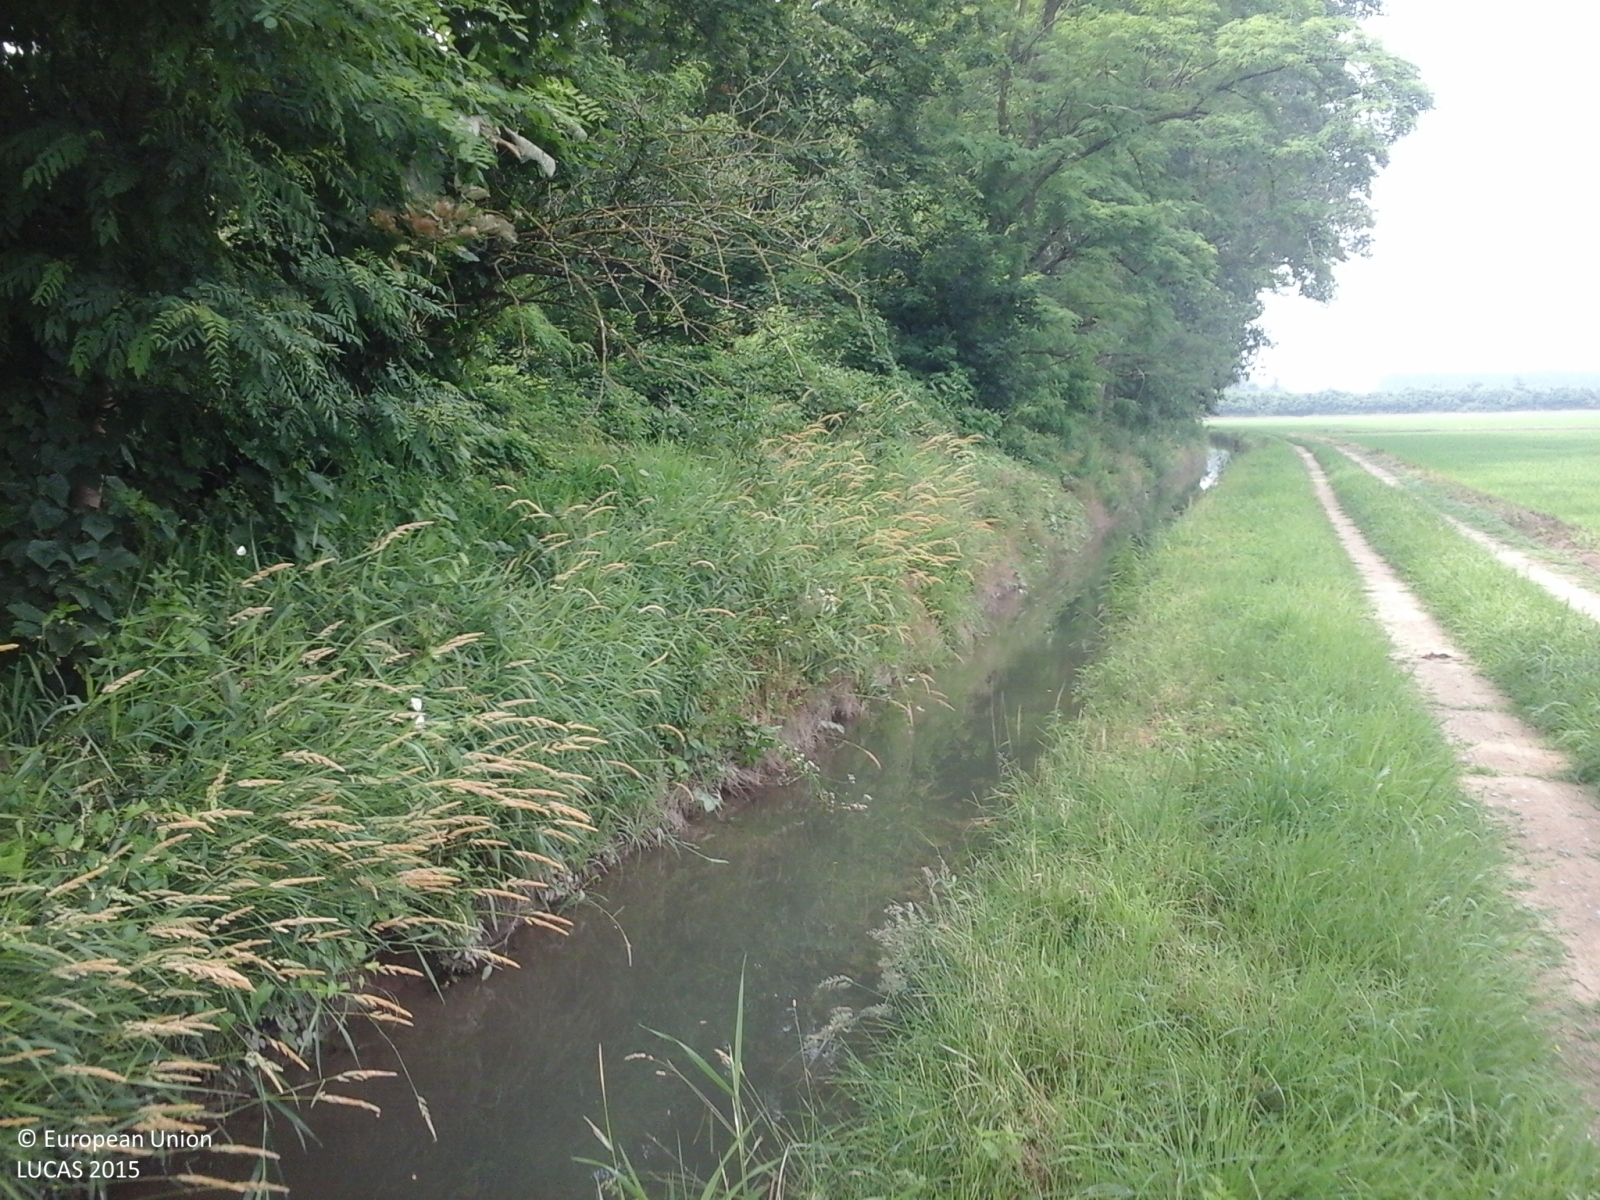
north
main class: Woodland
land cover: Broadleaved woodland
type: thermophilous deciduous forest
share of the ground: > 75 %
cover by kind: broadleaved forest trees 100 %
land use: Forestry
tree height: > 5 m
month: June
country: IT
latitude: 45.1911
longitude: 8.7930
